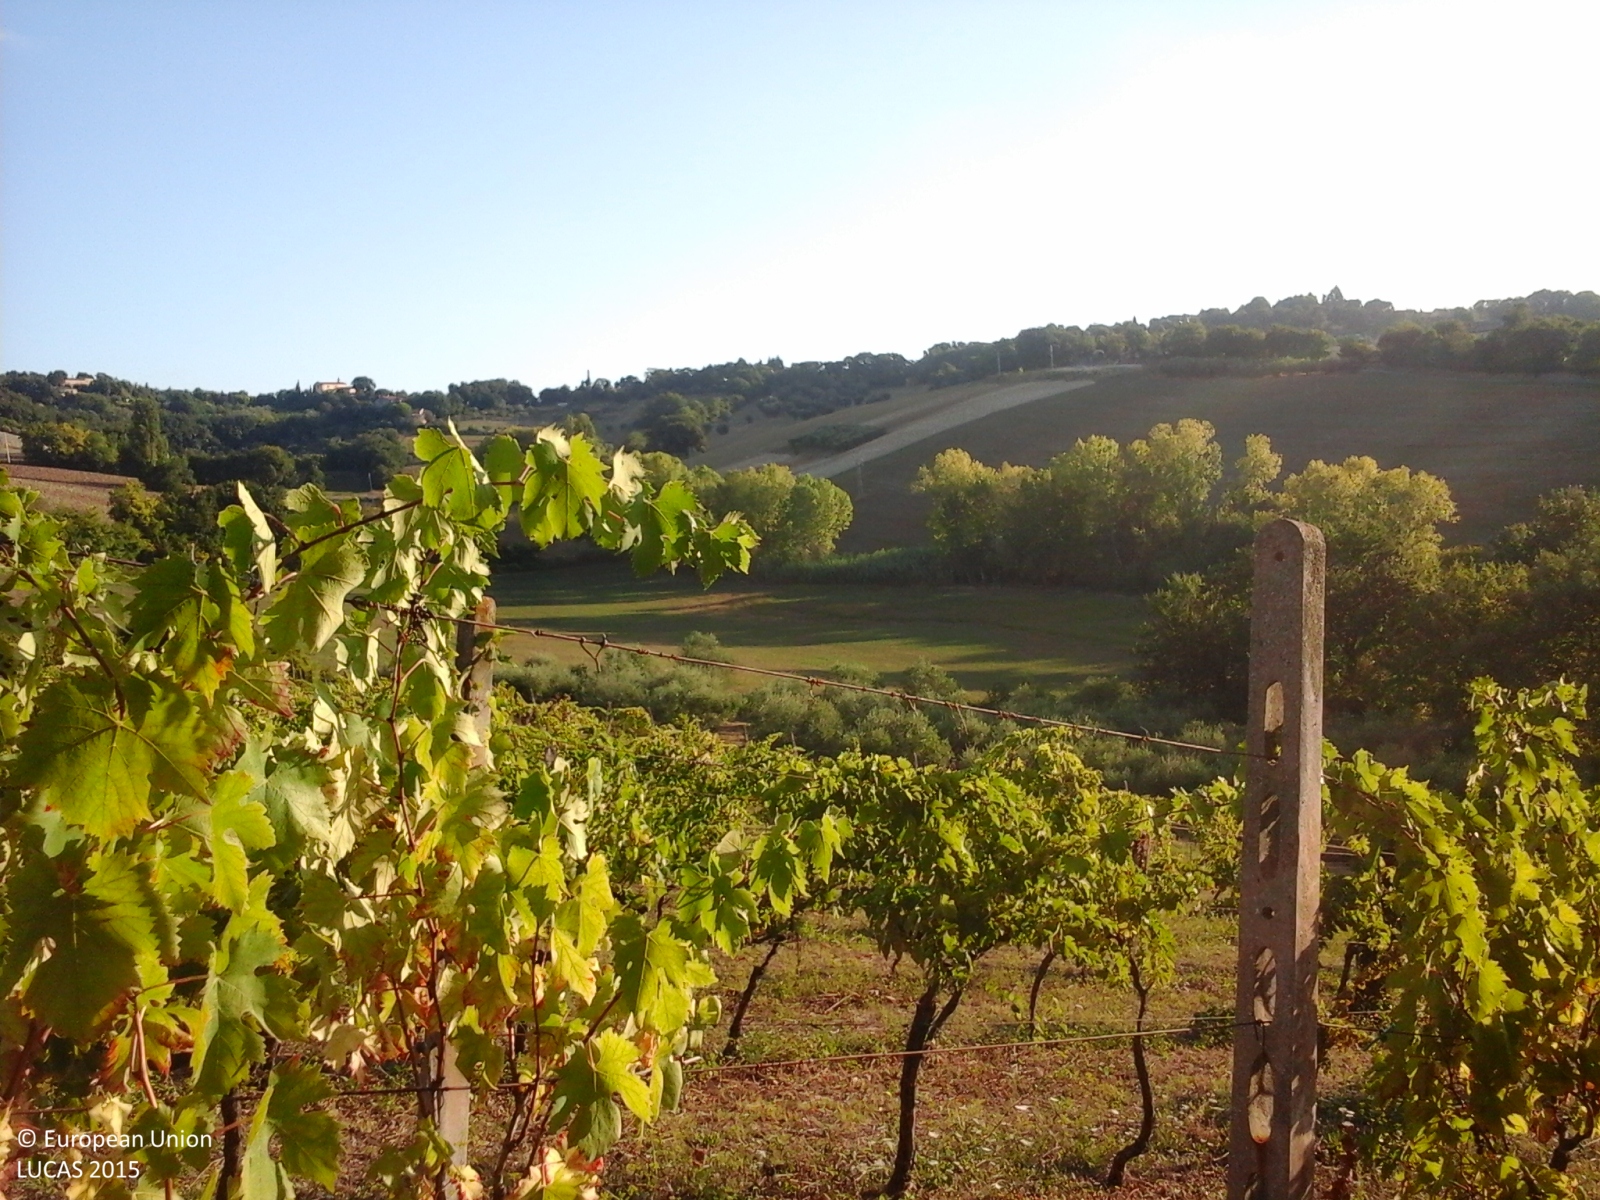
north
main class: Cropland
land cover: Vineyards
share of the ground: 50 - 75 %
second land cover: Grassland without tree/shrub cover
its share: > 75 %
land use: Agriculture (excluding fallow land and kitchen gardens)
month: September
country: IT
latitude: 43.8396
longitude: 12.9408
